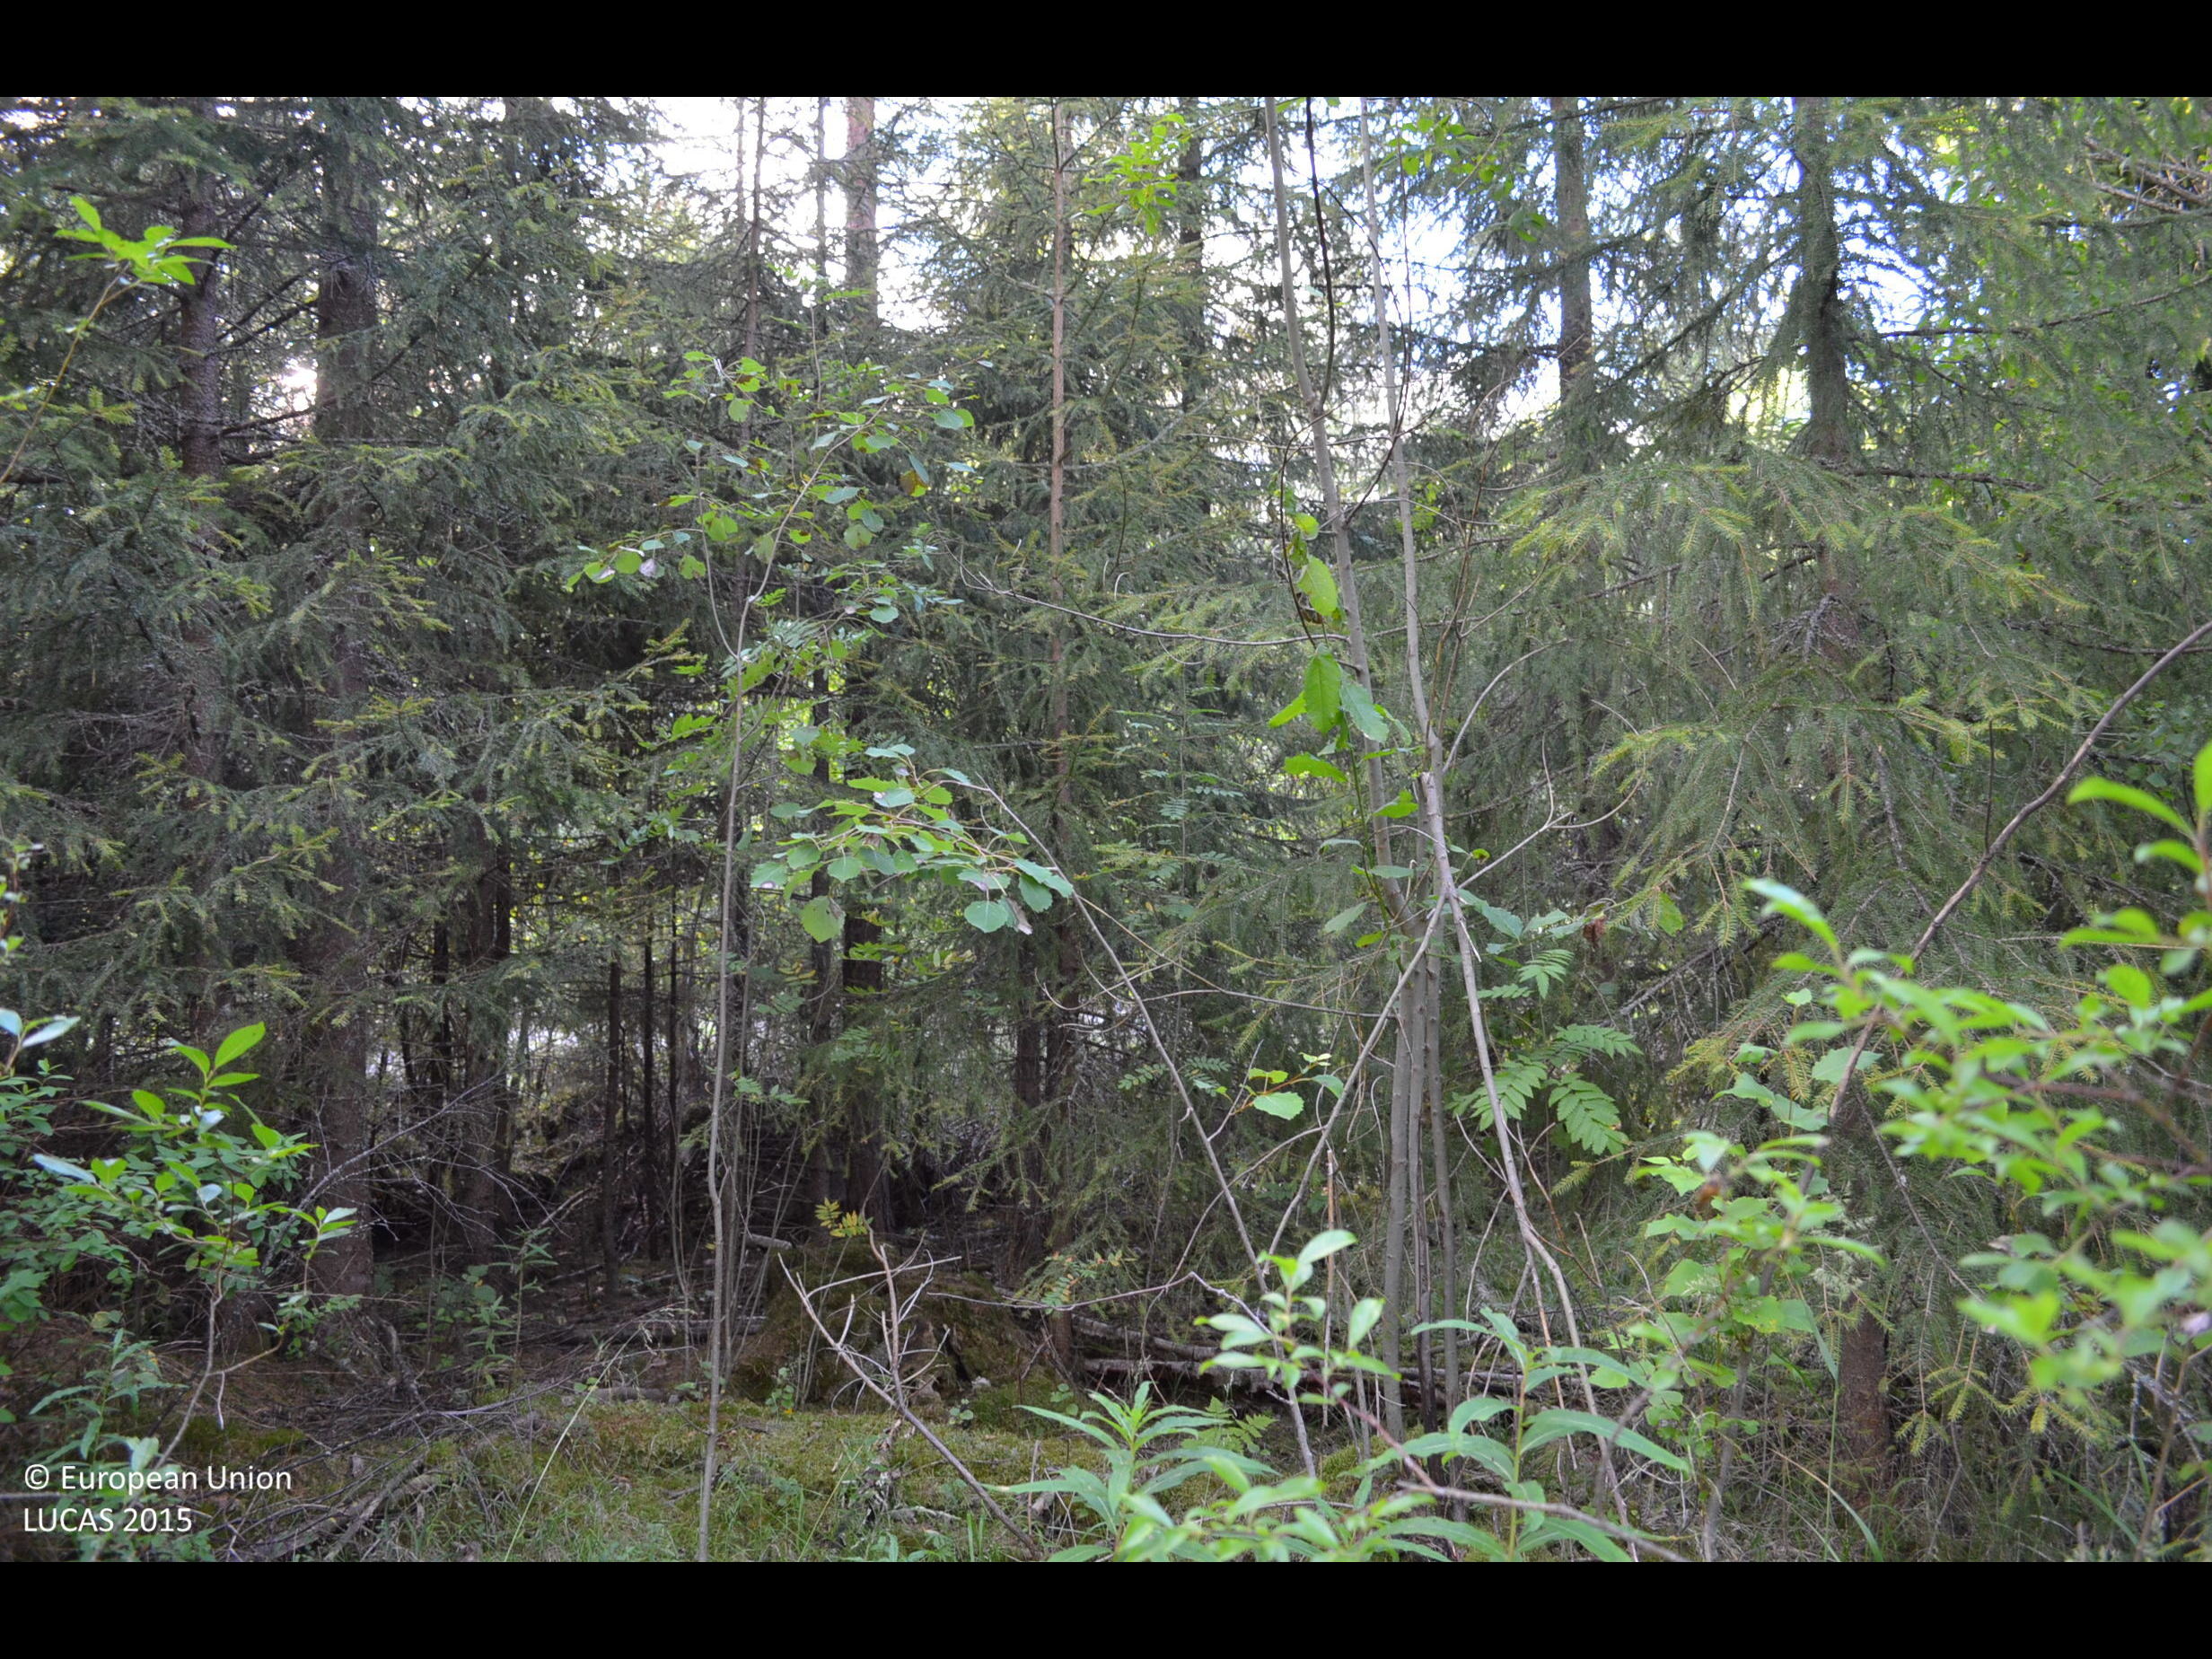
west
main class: Woodland
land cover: Spruce dominated mixed woodland
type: boreal forest
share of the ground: 50 - 75 %
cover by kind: coniferous forest trees 30 %, broadleaved forest trees 30 %, shrubs 25 %, herbaceous plants 15 %
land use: Forestry
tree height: > 5 m
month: August
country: FI
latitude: 62.3383
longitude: 24.3964
